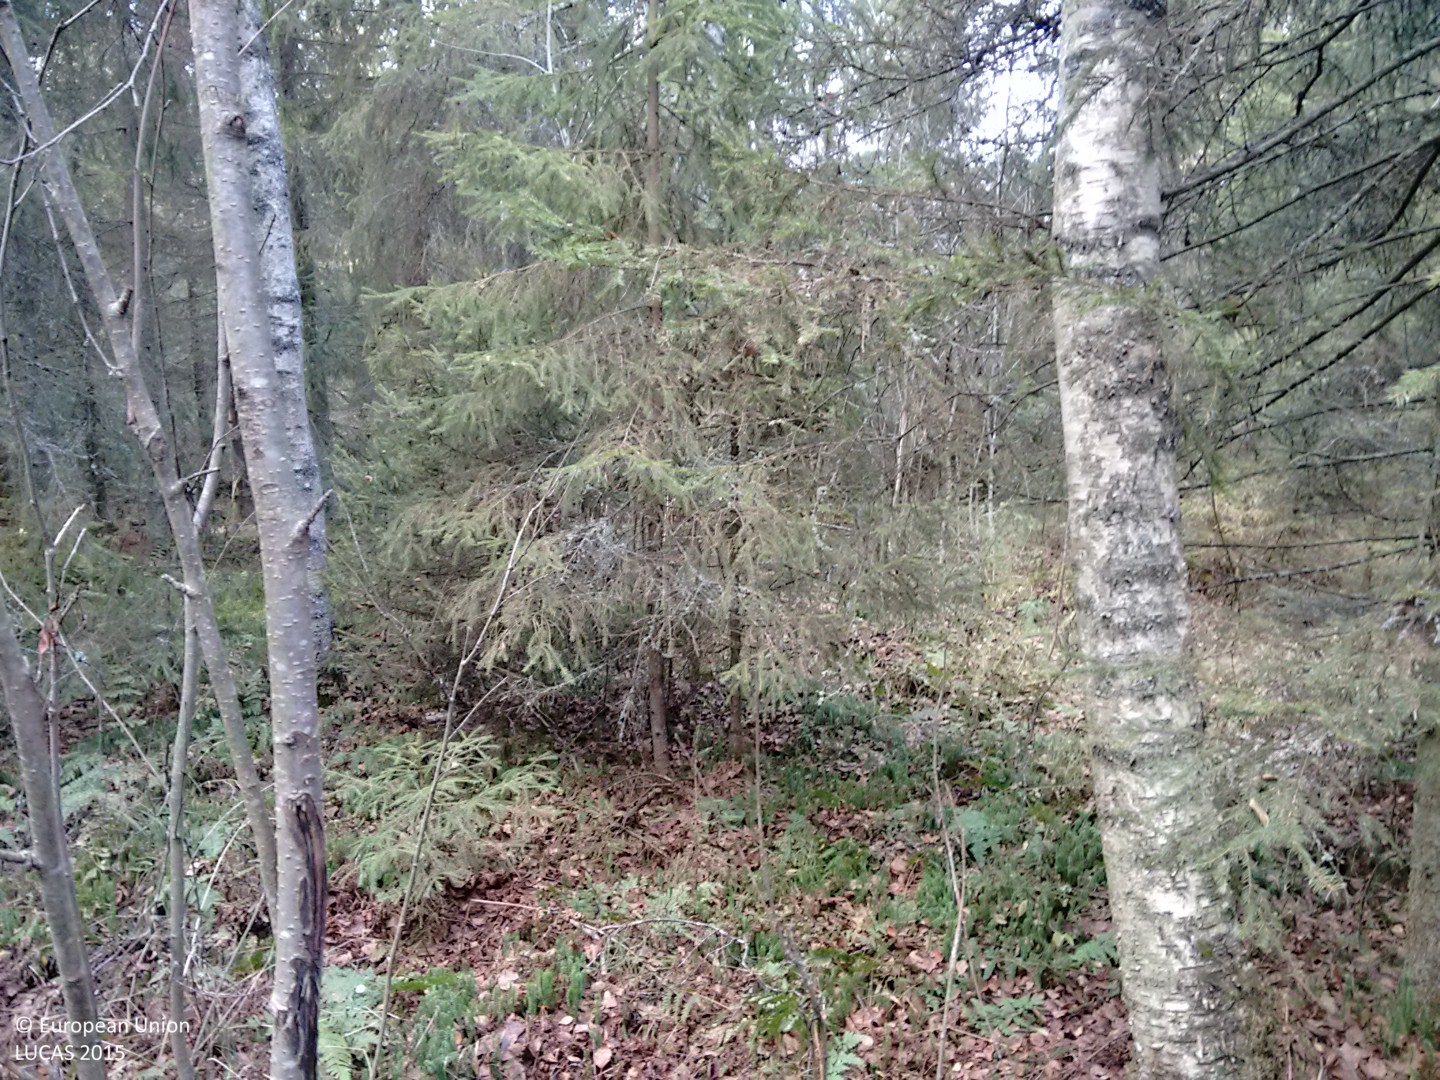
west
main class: Woodland
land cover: Spruce dominated mixed woodland
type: boreal forest
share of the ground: > 75 %
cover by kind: coniferous forest trees 60 %, broadleaved forest trees 25 %, herbaceous plants 10 %, shrubs 5 %
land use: Forestry
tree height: > 5 m
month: October
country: FI
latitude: 63.9186
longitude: 25.1964
